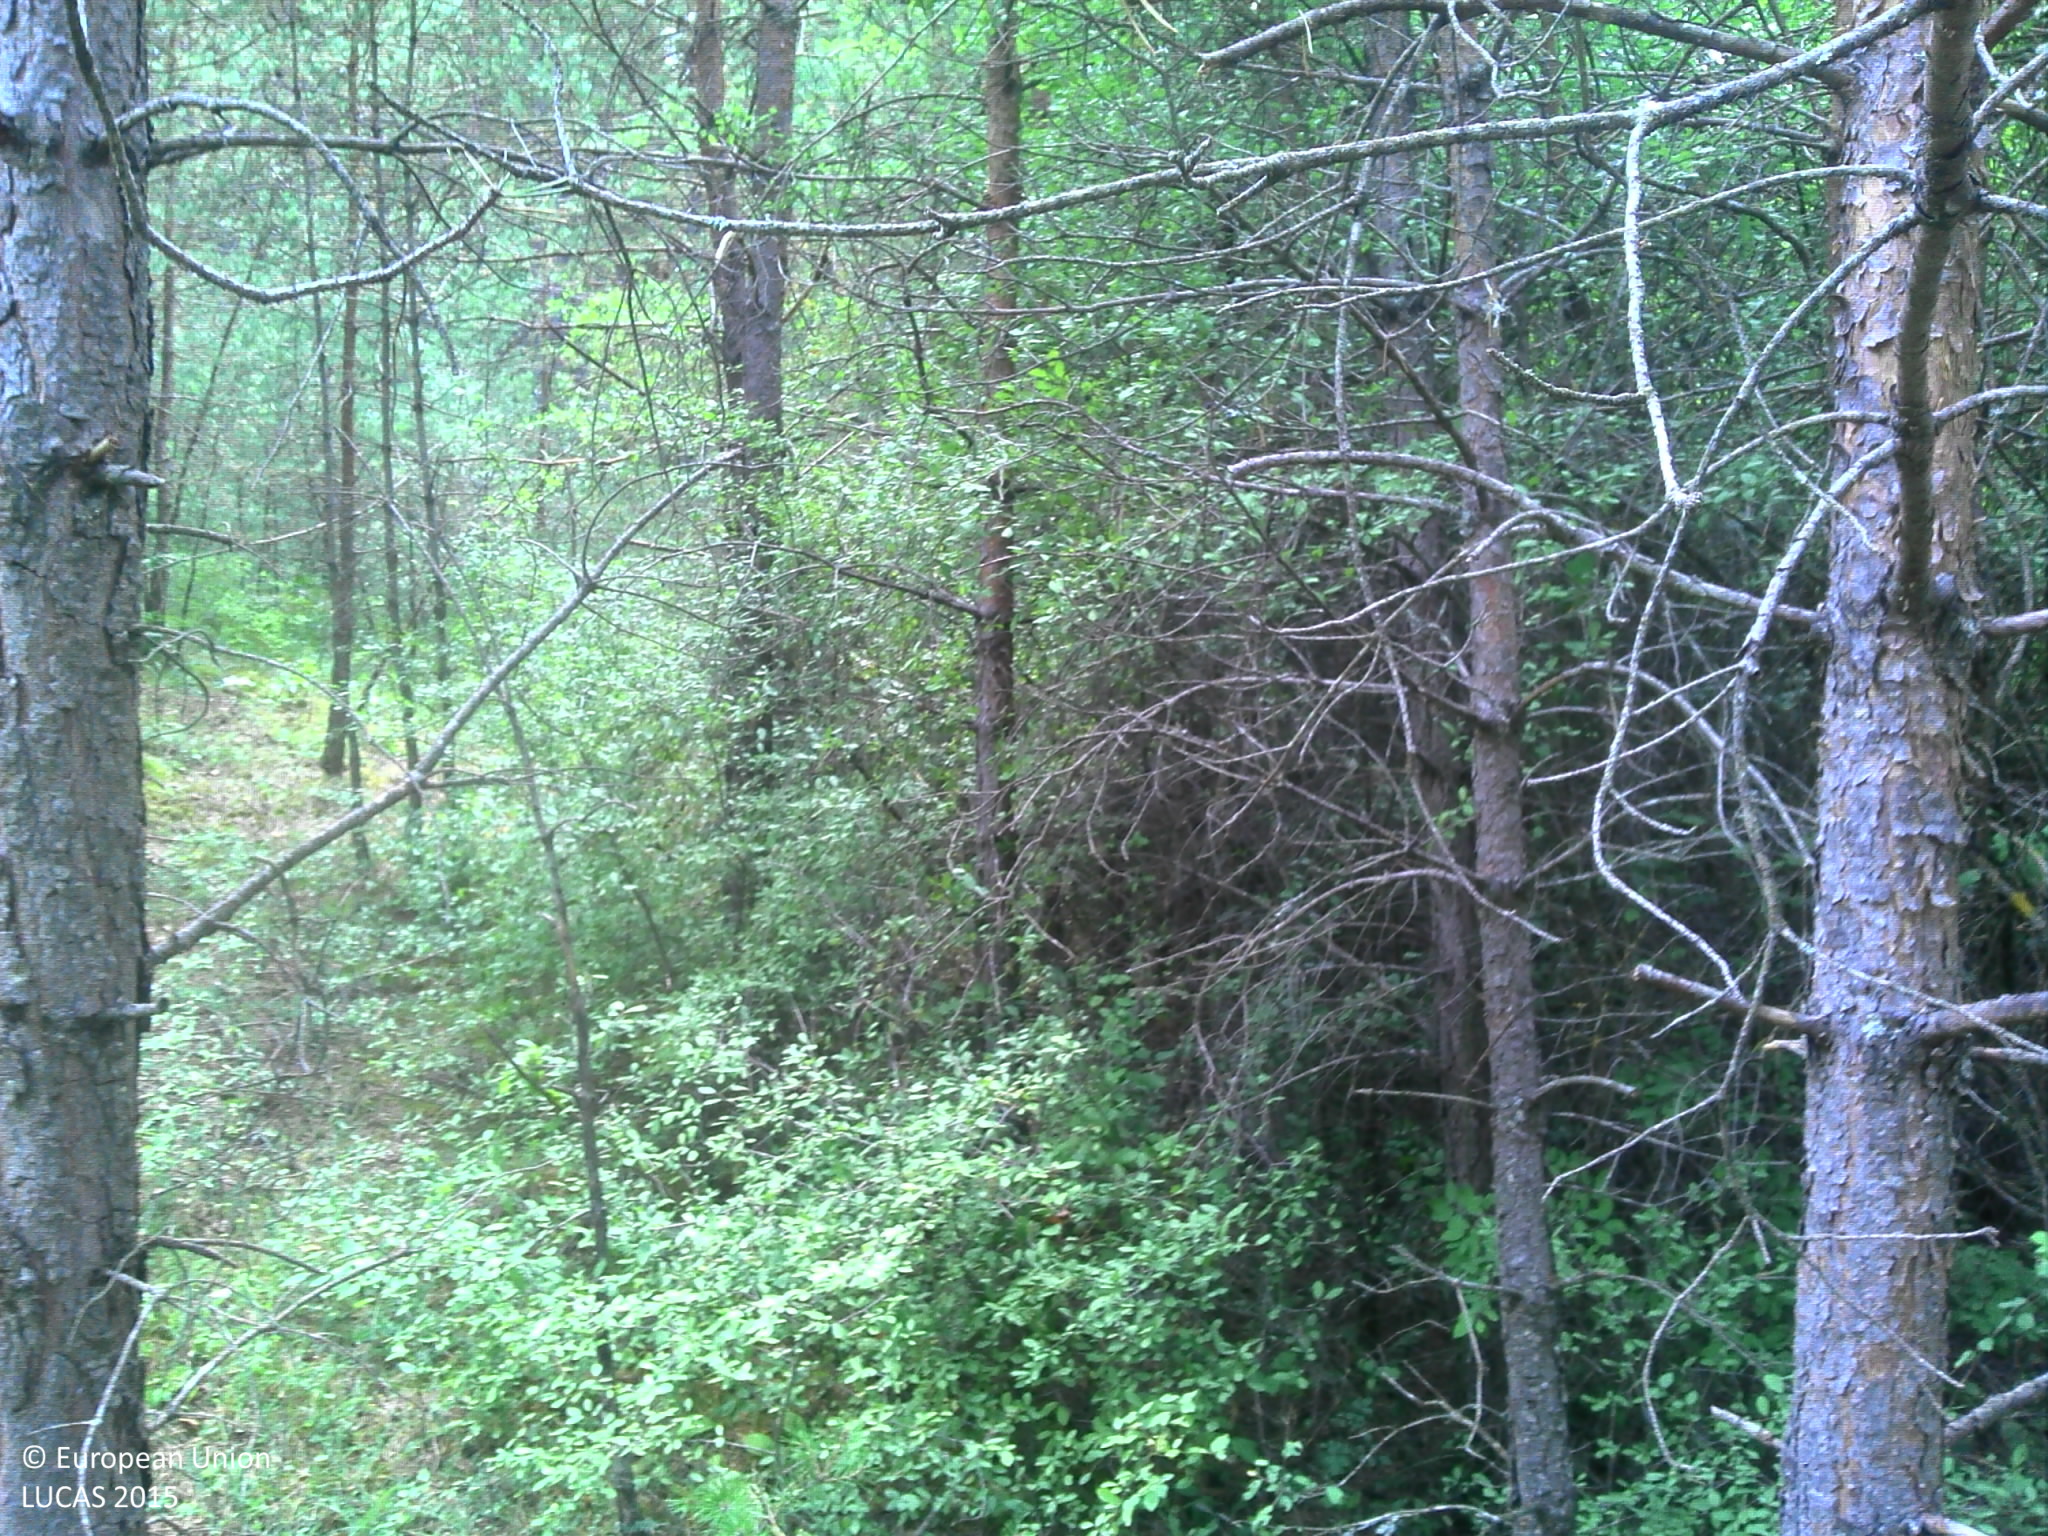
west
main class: Woodland
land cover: Pine dominated coniferous woodland
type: coniferous forest of the mediterranean region
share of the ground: > 75 %
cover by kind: coniferous forest trees 80 %, herbaceous plants 10 %, consolidated bare surface 10 %
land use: Forestry
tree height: > 5 m
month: August
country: FR
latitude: 43.9831
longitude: 6.4543
